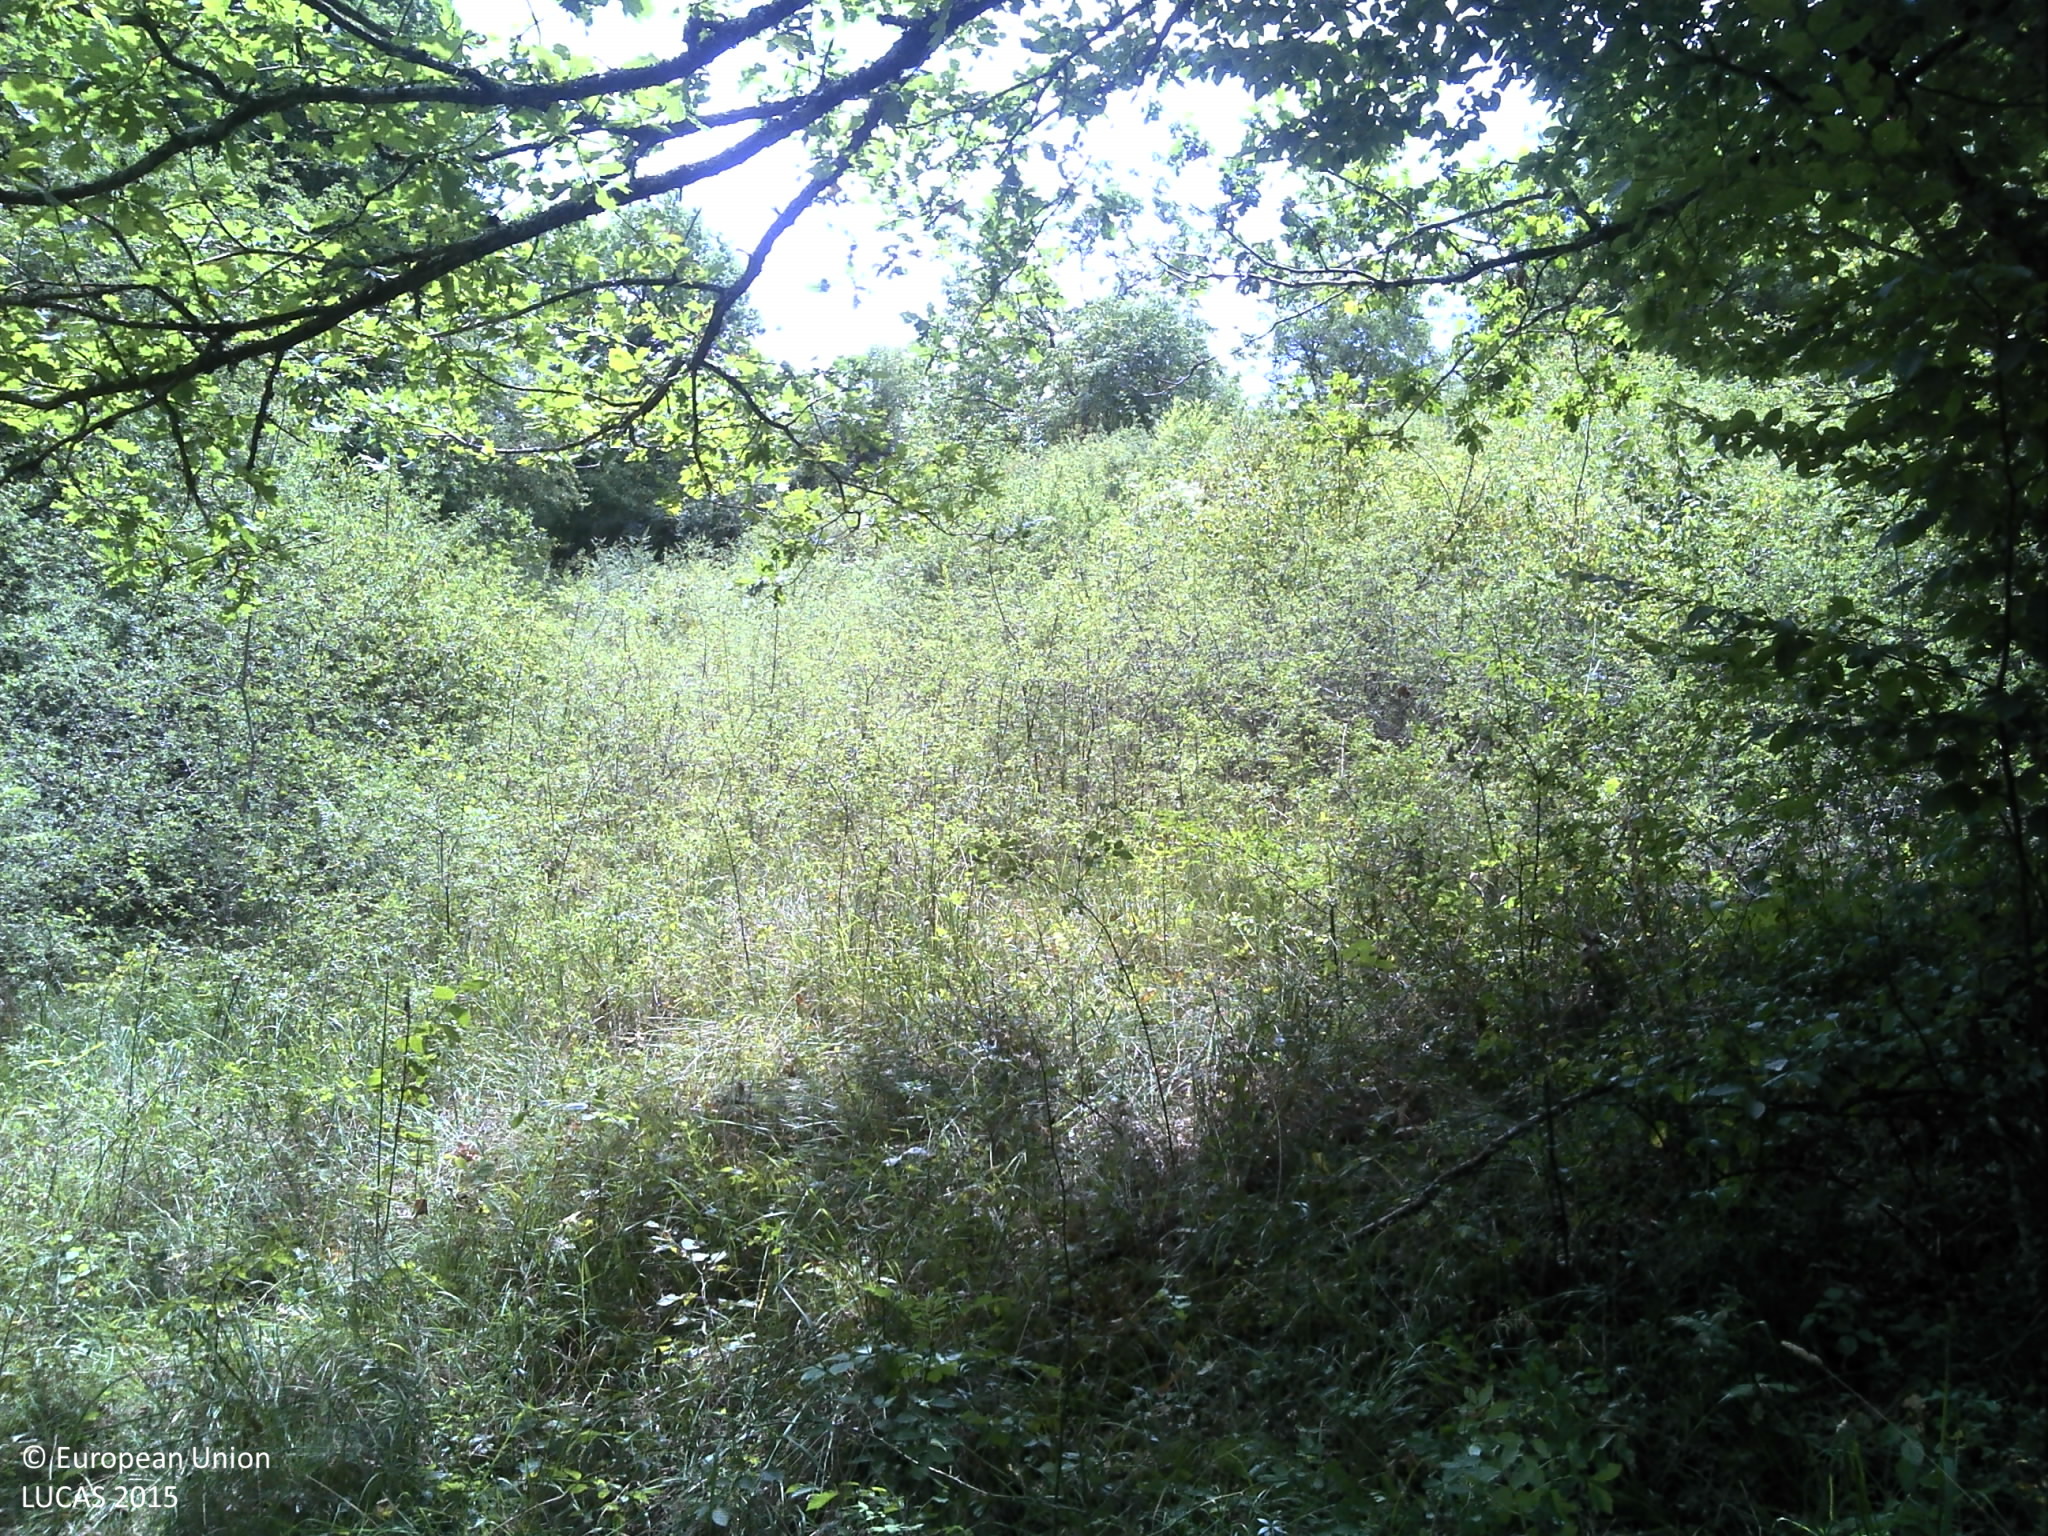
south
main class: Woodland
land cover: Broadleaved woodland
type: mesophytic deciduous forest
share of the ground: 50 - 75 %
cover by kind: broadleaved forest trees 55 %, herbaceous plants 35 %, shrubs 5 %, lichens and mosses 5 %
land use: Forestry
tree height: > 5 m
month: July
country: FR
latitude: 44.9474
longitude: 1.7719
